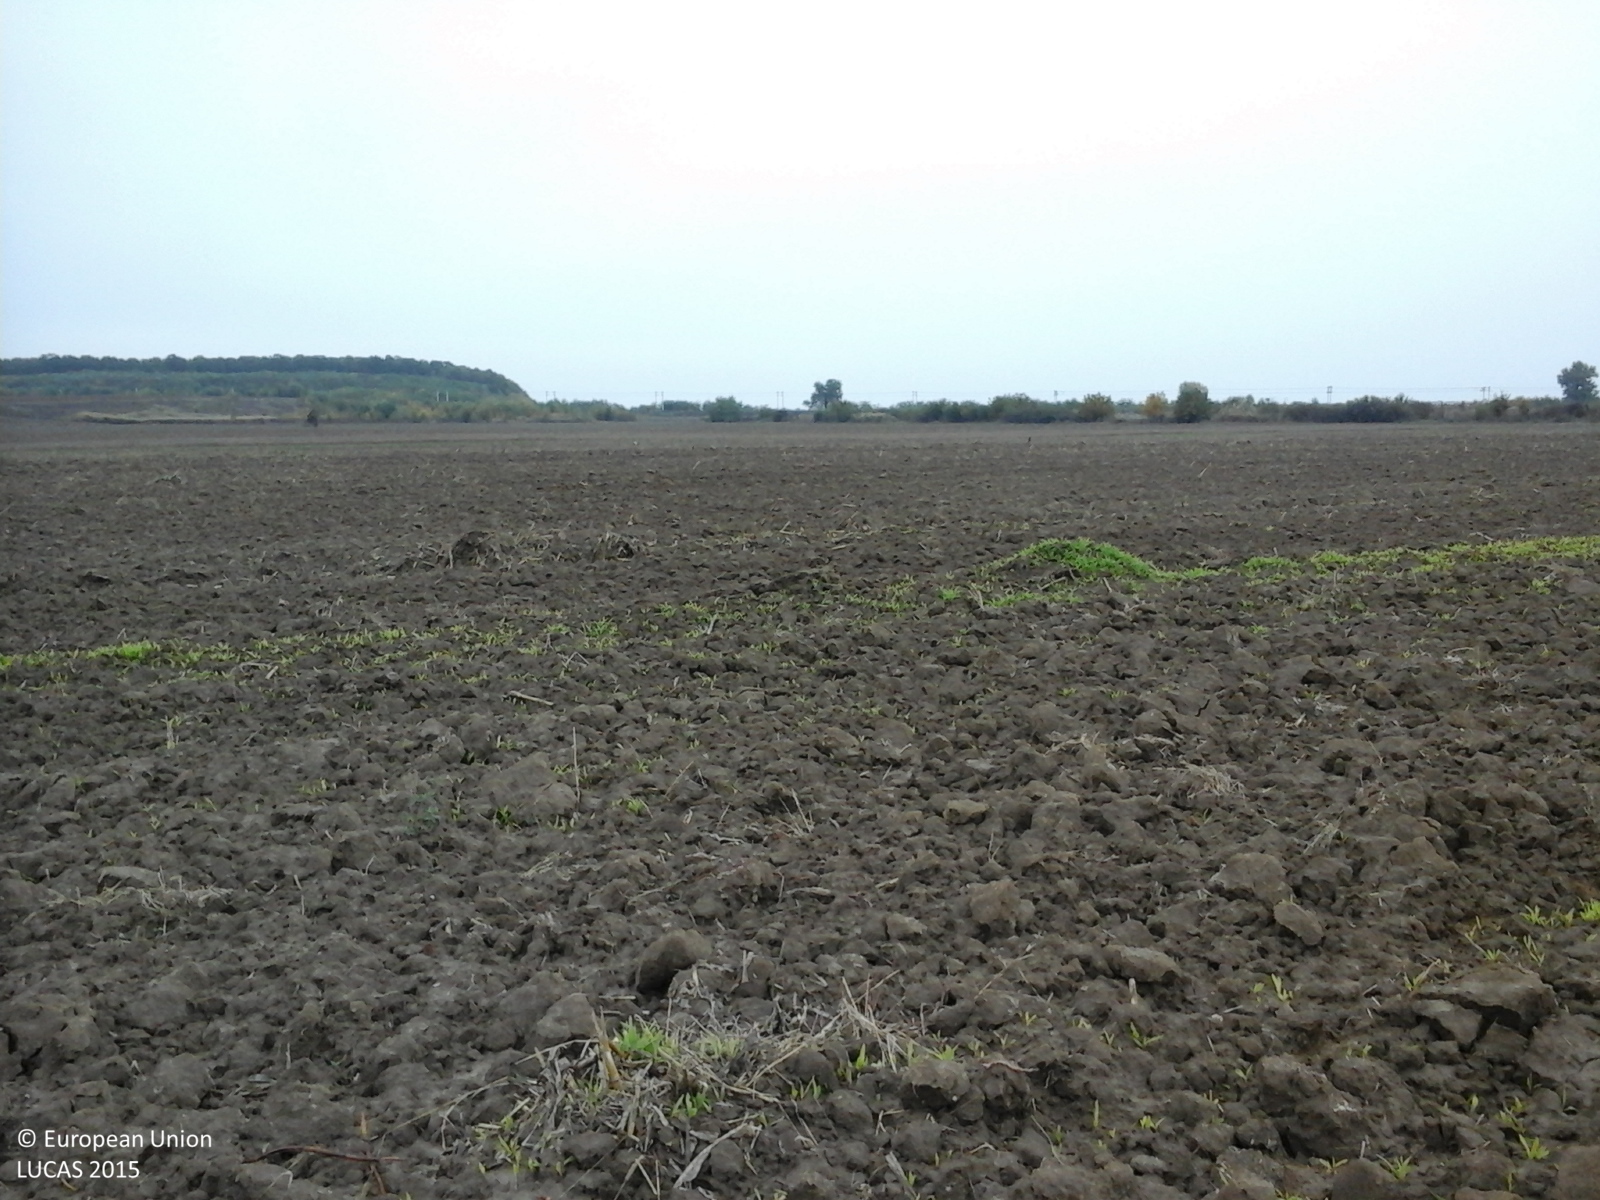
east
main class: Cropland
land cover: Maize
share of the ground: < 10 %
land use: Agriculture (excluding fallow land and kitchen gardens)
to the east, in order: Maize; Common wheat; Lucerne; Common wheat; Other bare soil
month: October
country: RO
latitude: 44.8204
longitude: 26.0290
